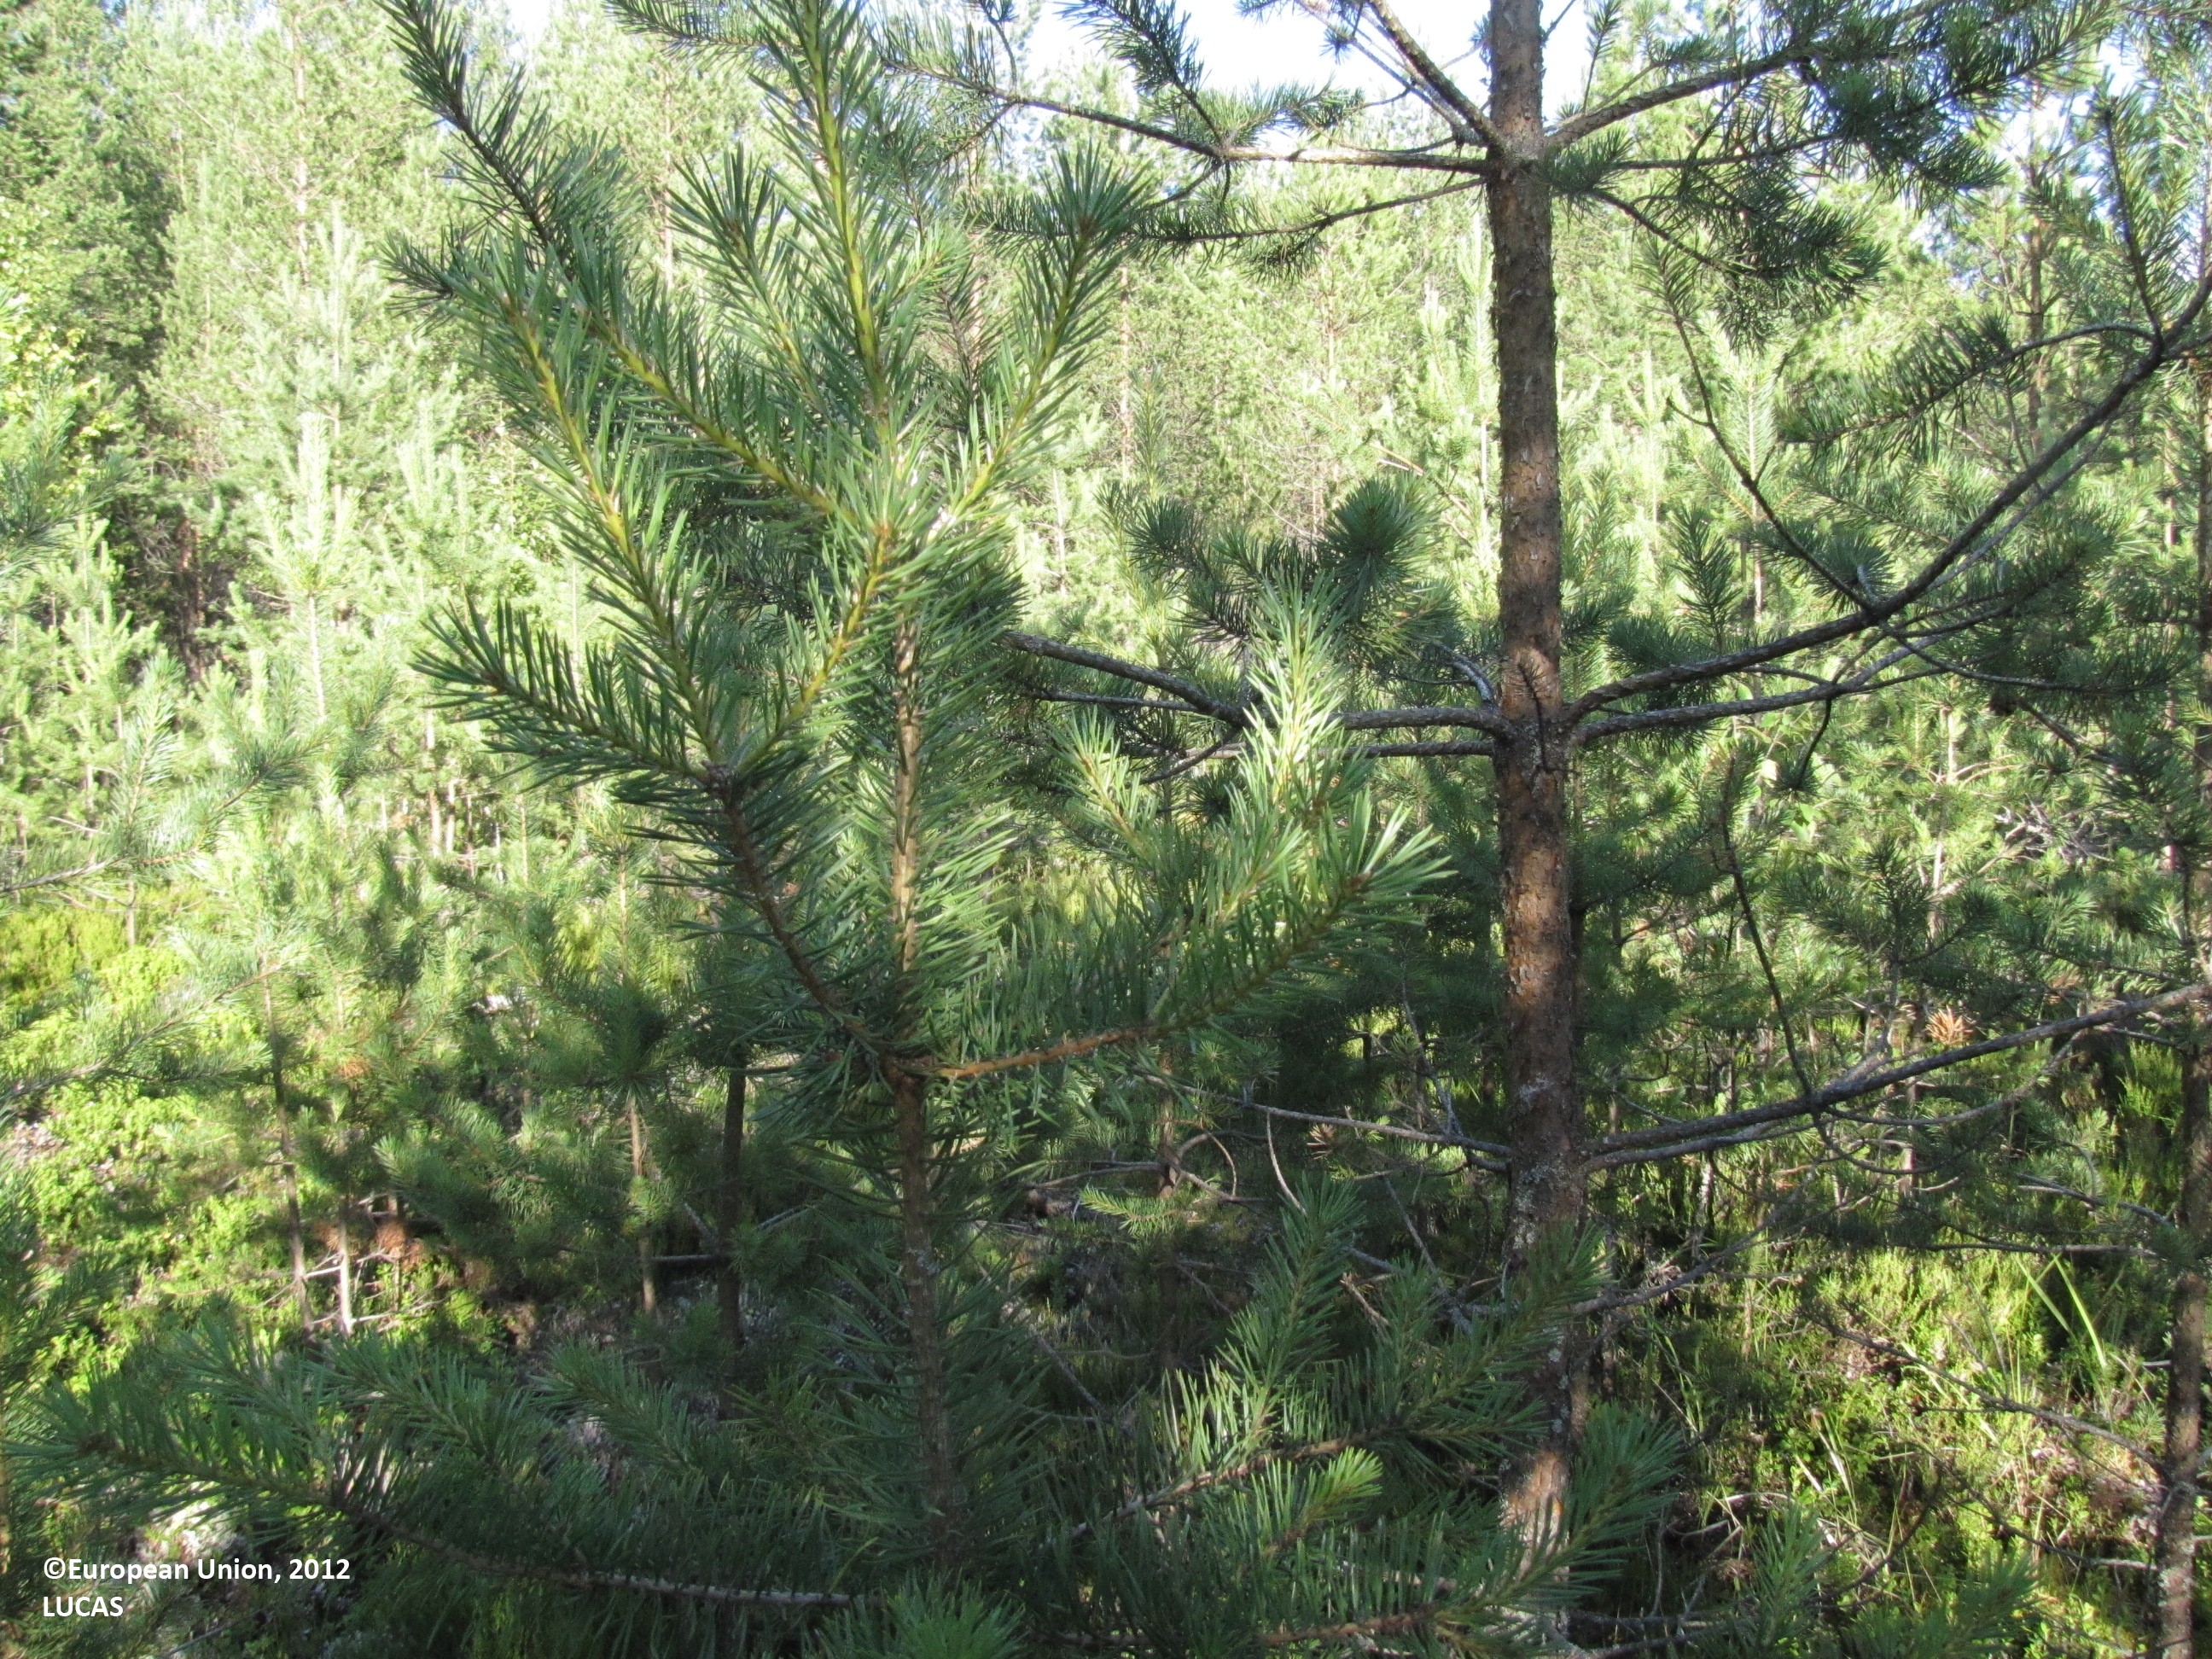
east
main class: Woodland
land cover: Pine dominated coniferous woodland
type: boreal forest
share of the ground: 25 - 50 %
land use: Forestry
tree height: > 5 m
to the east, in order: Pine dominated coniferous woodland
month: July
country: FI
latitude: 62.5213
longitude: 23.2179
